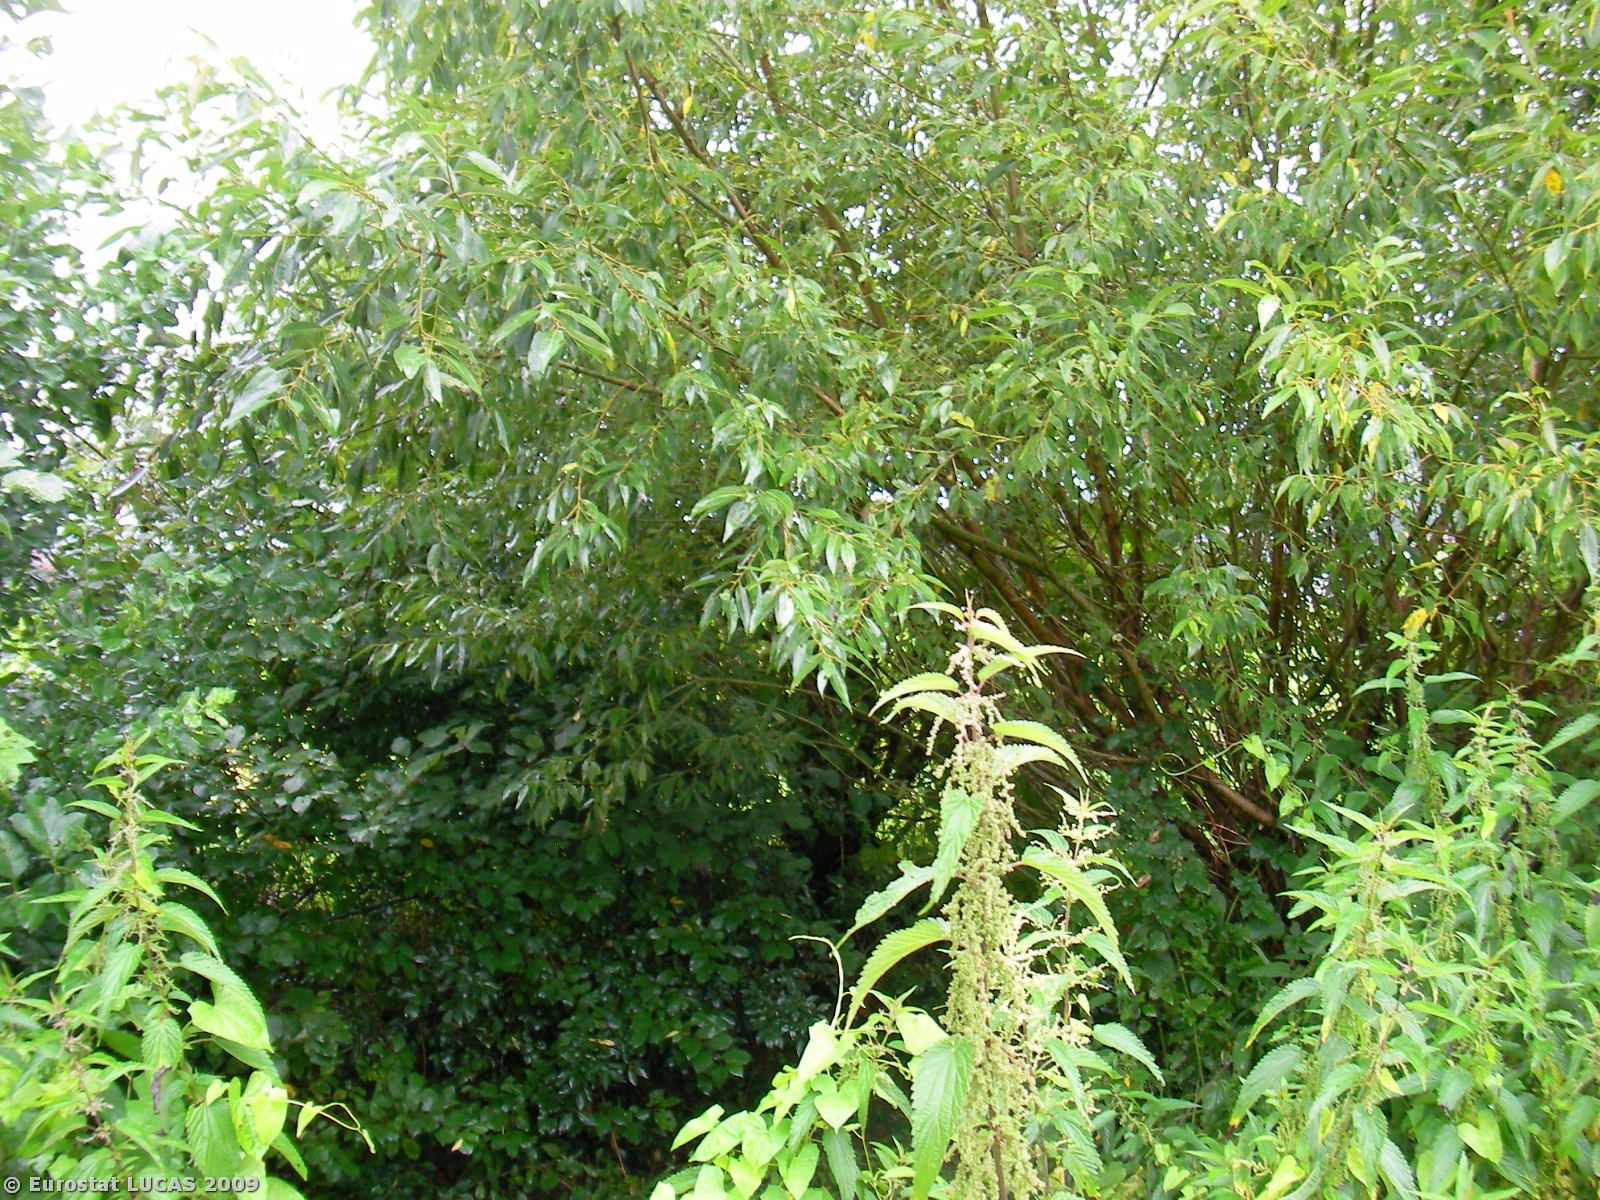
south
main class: Cropland
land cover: Other fibre and oleaginous crops
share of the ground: > 75 %
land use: Agriculture (excluding fallow land and kitchen gardens)
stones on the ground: < 10 %
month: July
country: AT
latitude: 46.9386
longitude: 15.7144
